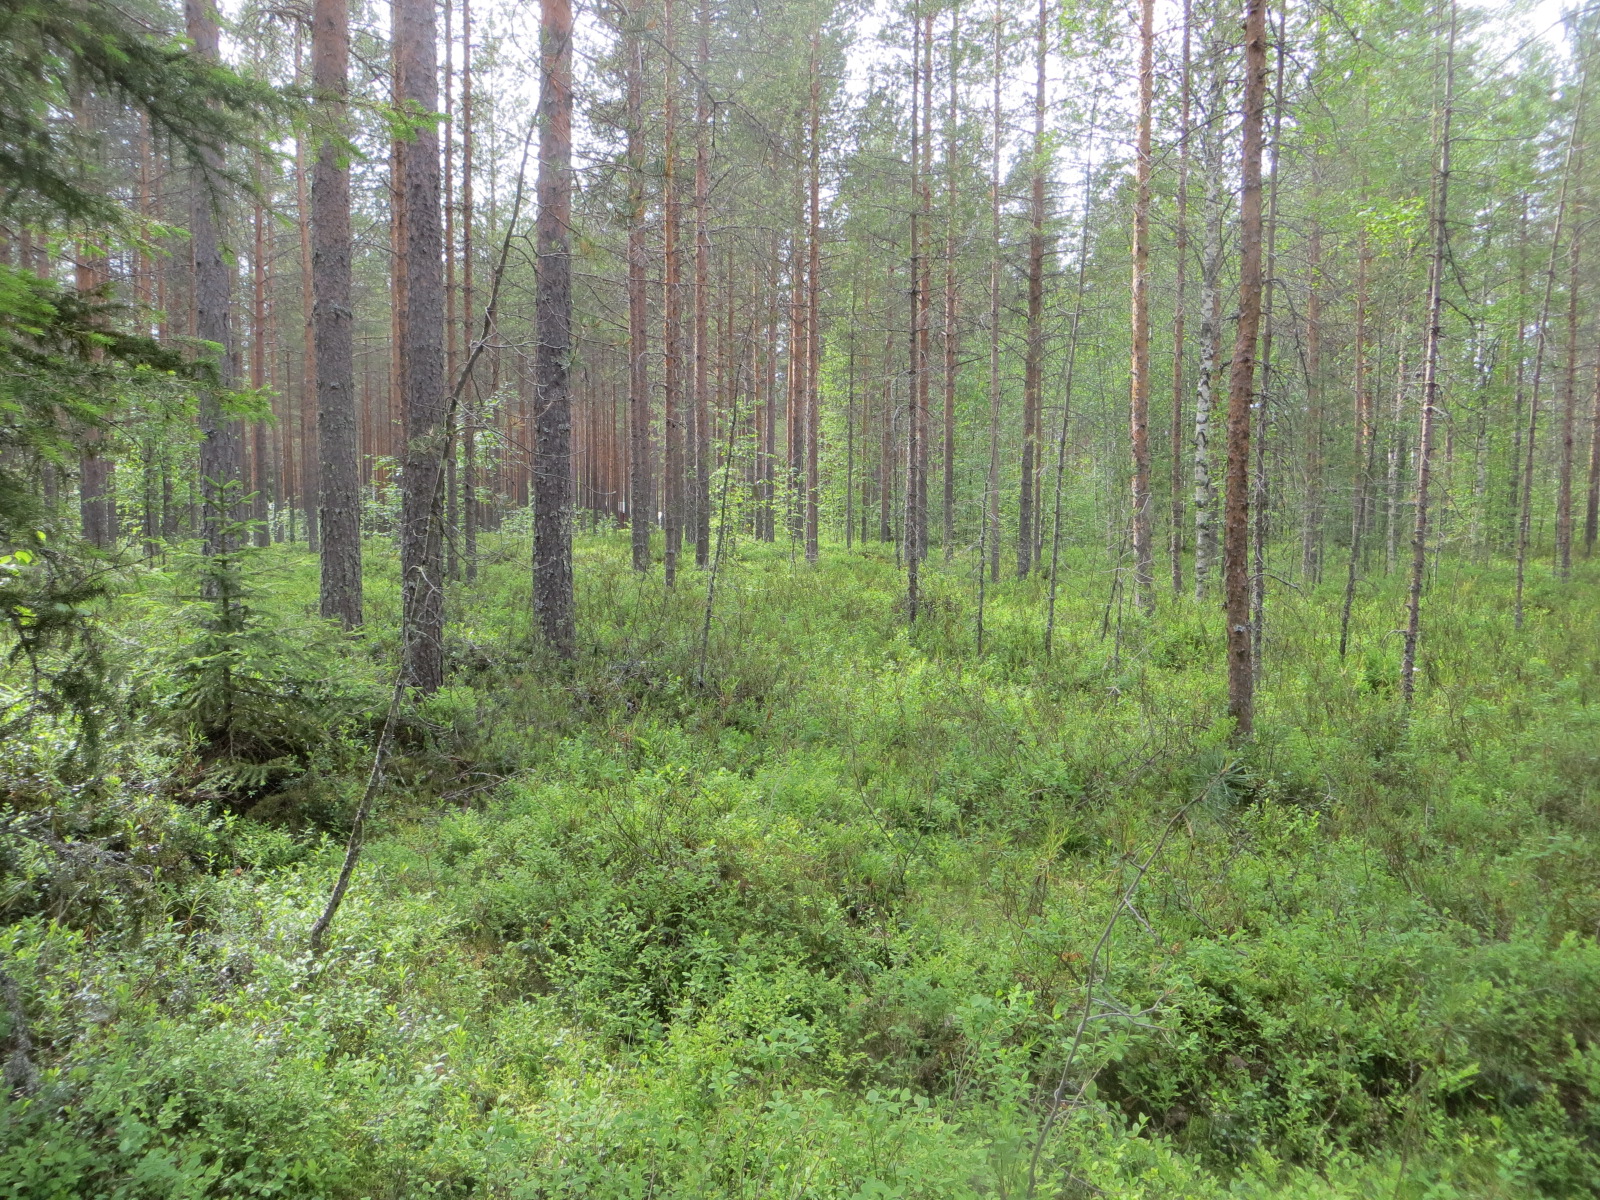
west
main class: Woodland
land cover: Pine dominated coniferous woodland
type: boreal forest
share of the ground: 50 - 75 %
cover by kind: coniferous forest trees 65 %, shrubs 30 %, broadleaved forest trees 5 %
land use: Forestry
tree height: > 5 m
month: July
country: FI
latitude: 65.3676
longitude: 25.8924
